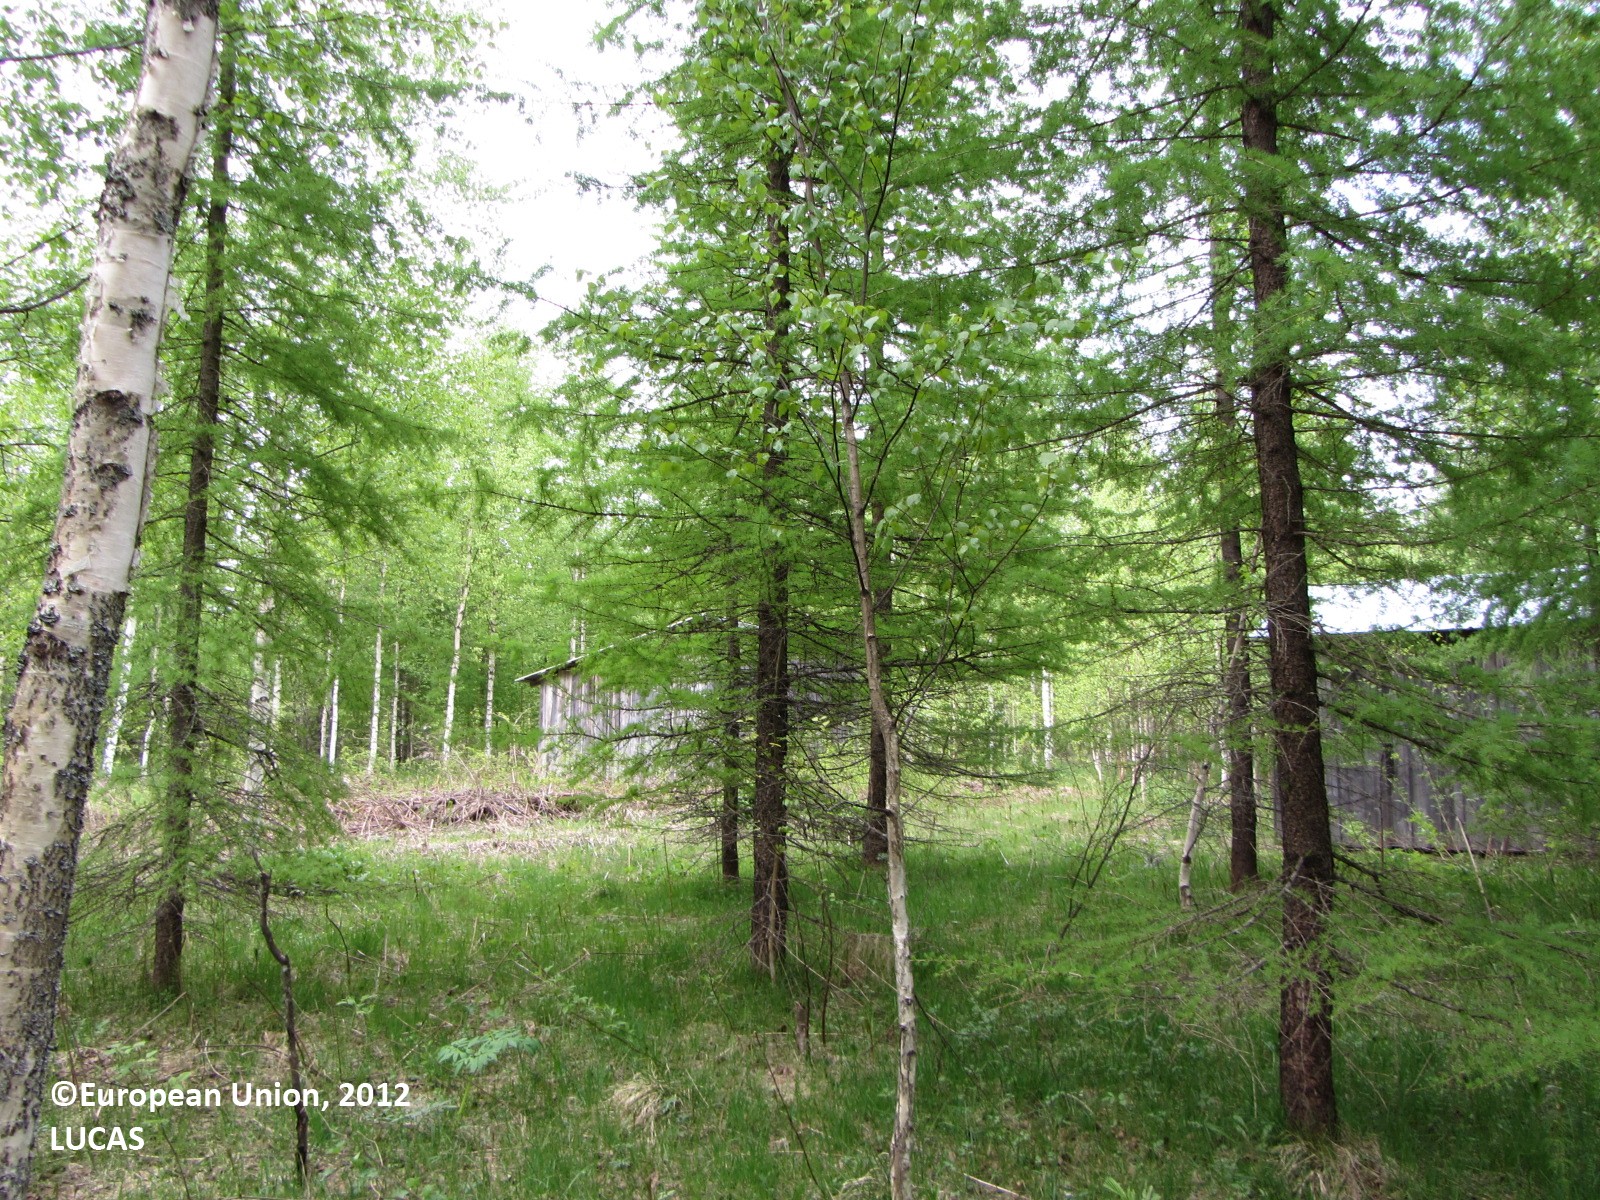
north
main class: Woodland
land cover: Broadleaved woodland
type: boreal forest
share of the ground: > 75 %
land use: Forestry
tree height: > 5 m
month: May
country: FI
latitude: 62.4014
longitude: 25.4156
